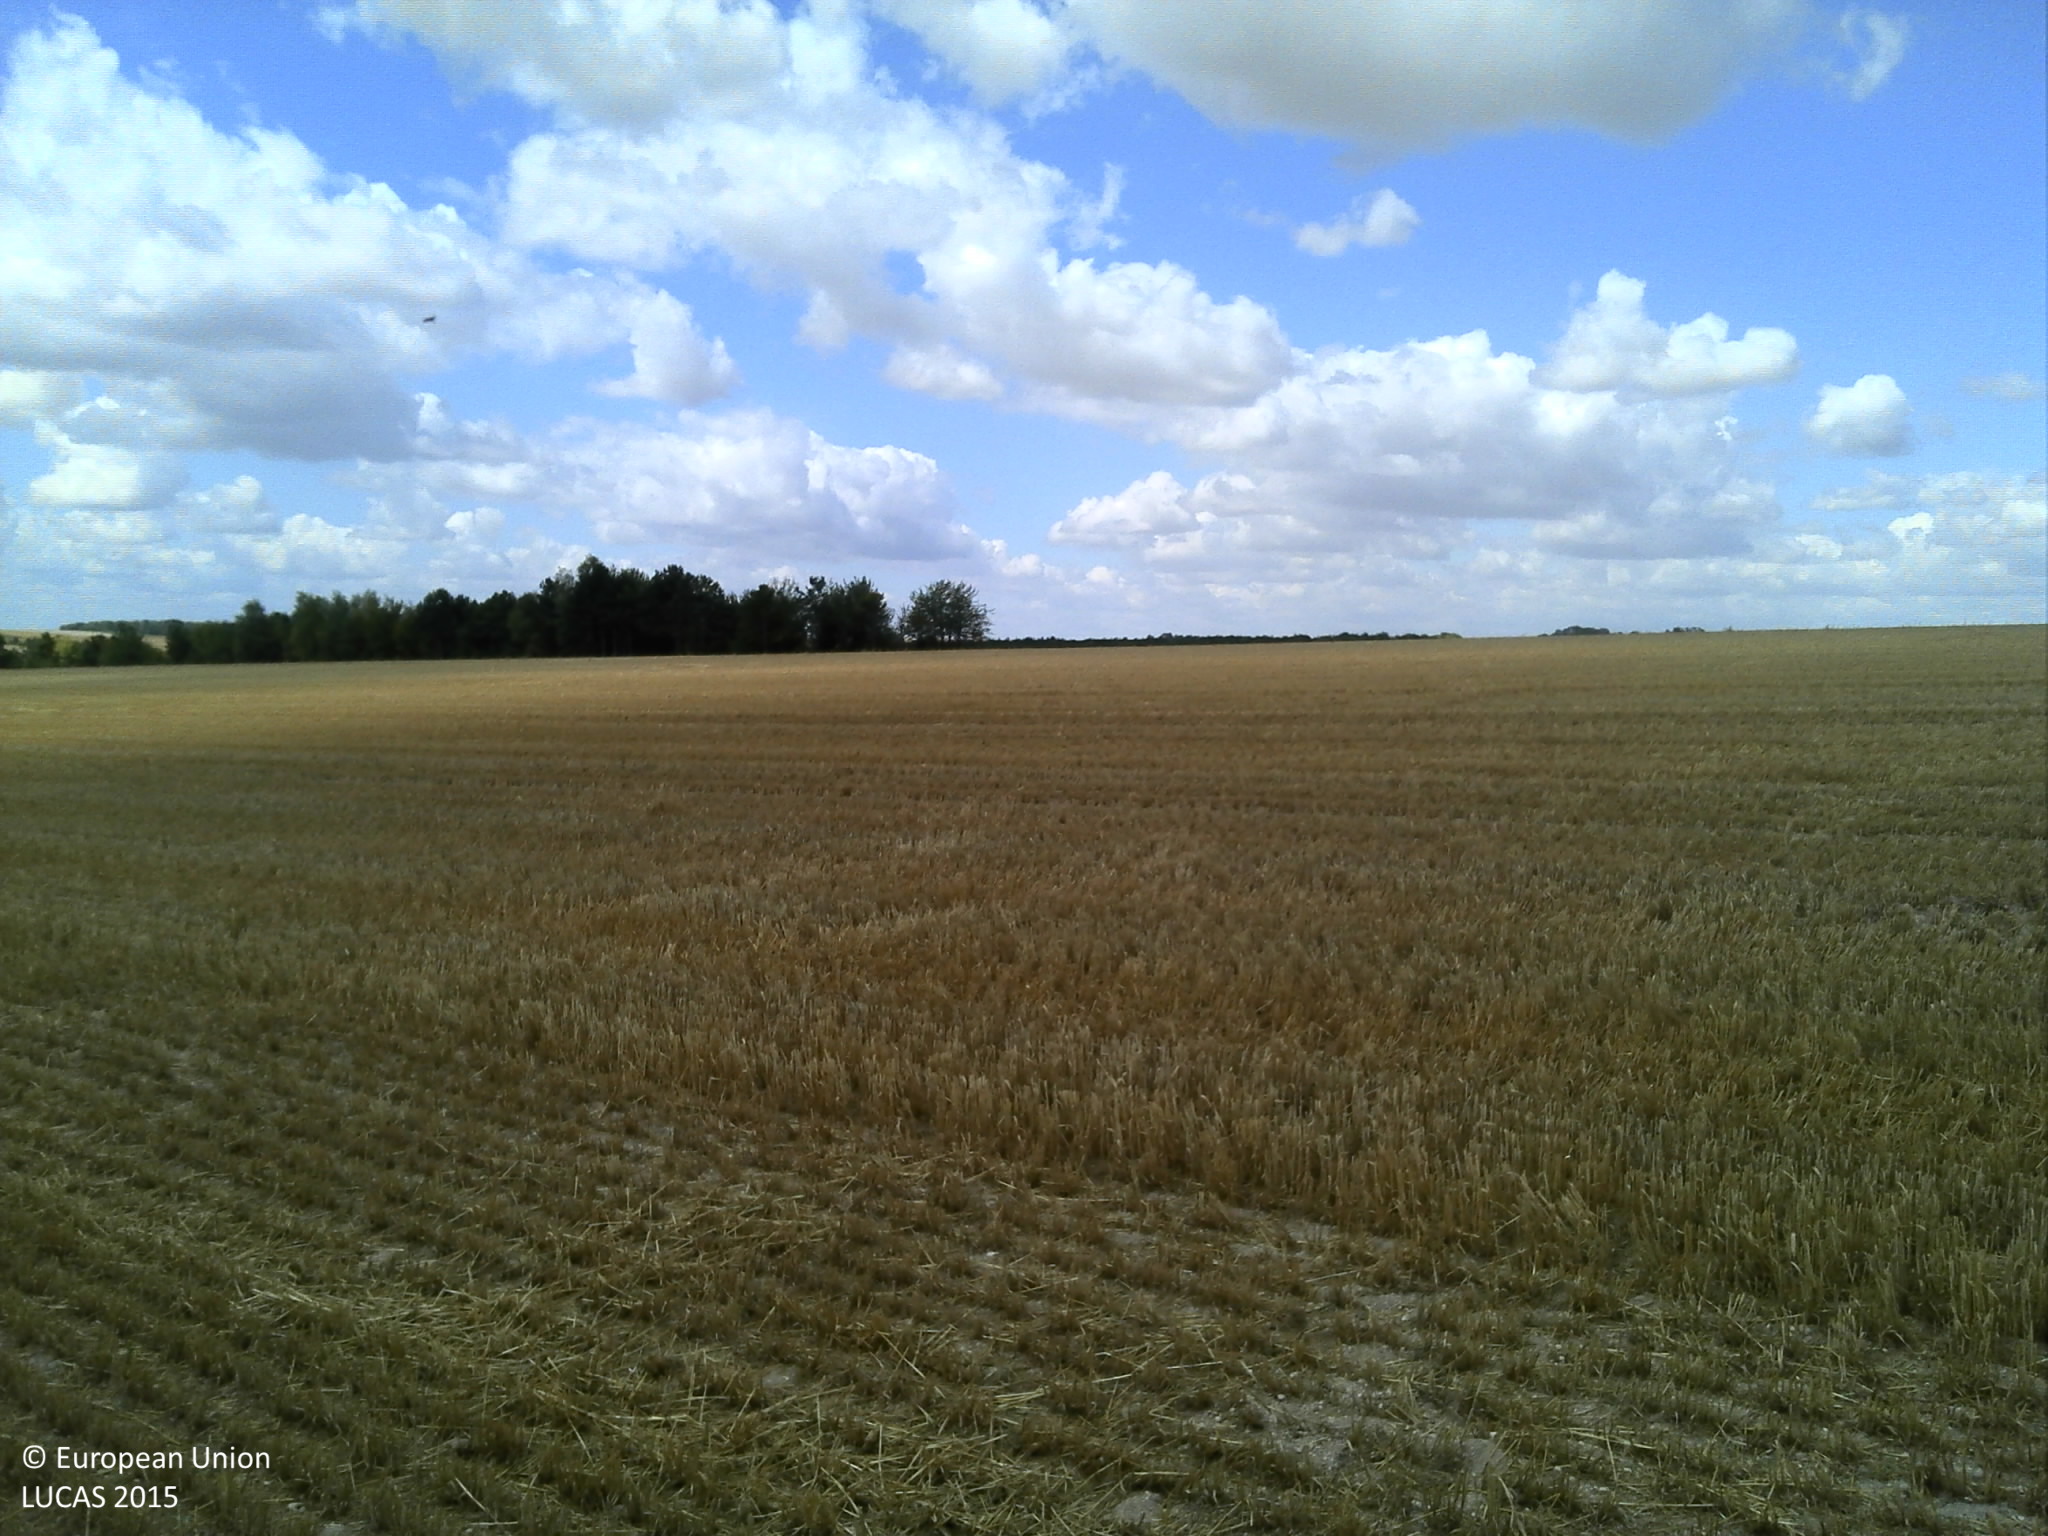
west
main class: Cropland
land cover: Barley
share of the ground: 50 - 75 %
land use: Agriculture (excluding fallow land and kitchen gardens)
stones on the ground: < 10 %
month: July
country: FR
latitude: 49.3002
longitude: 4.6197
